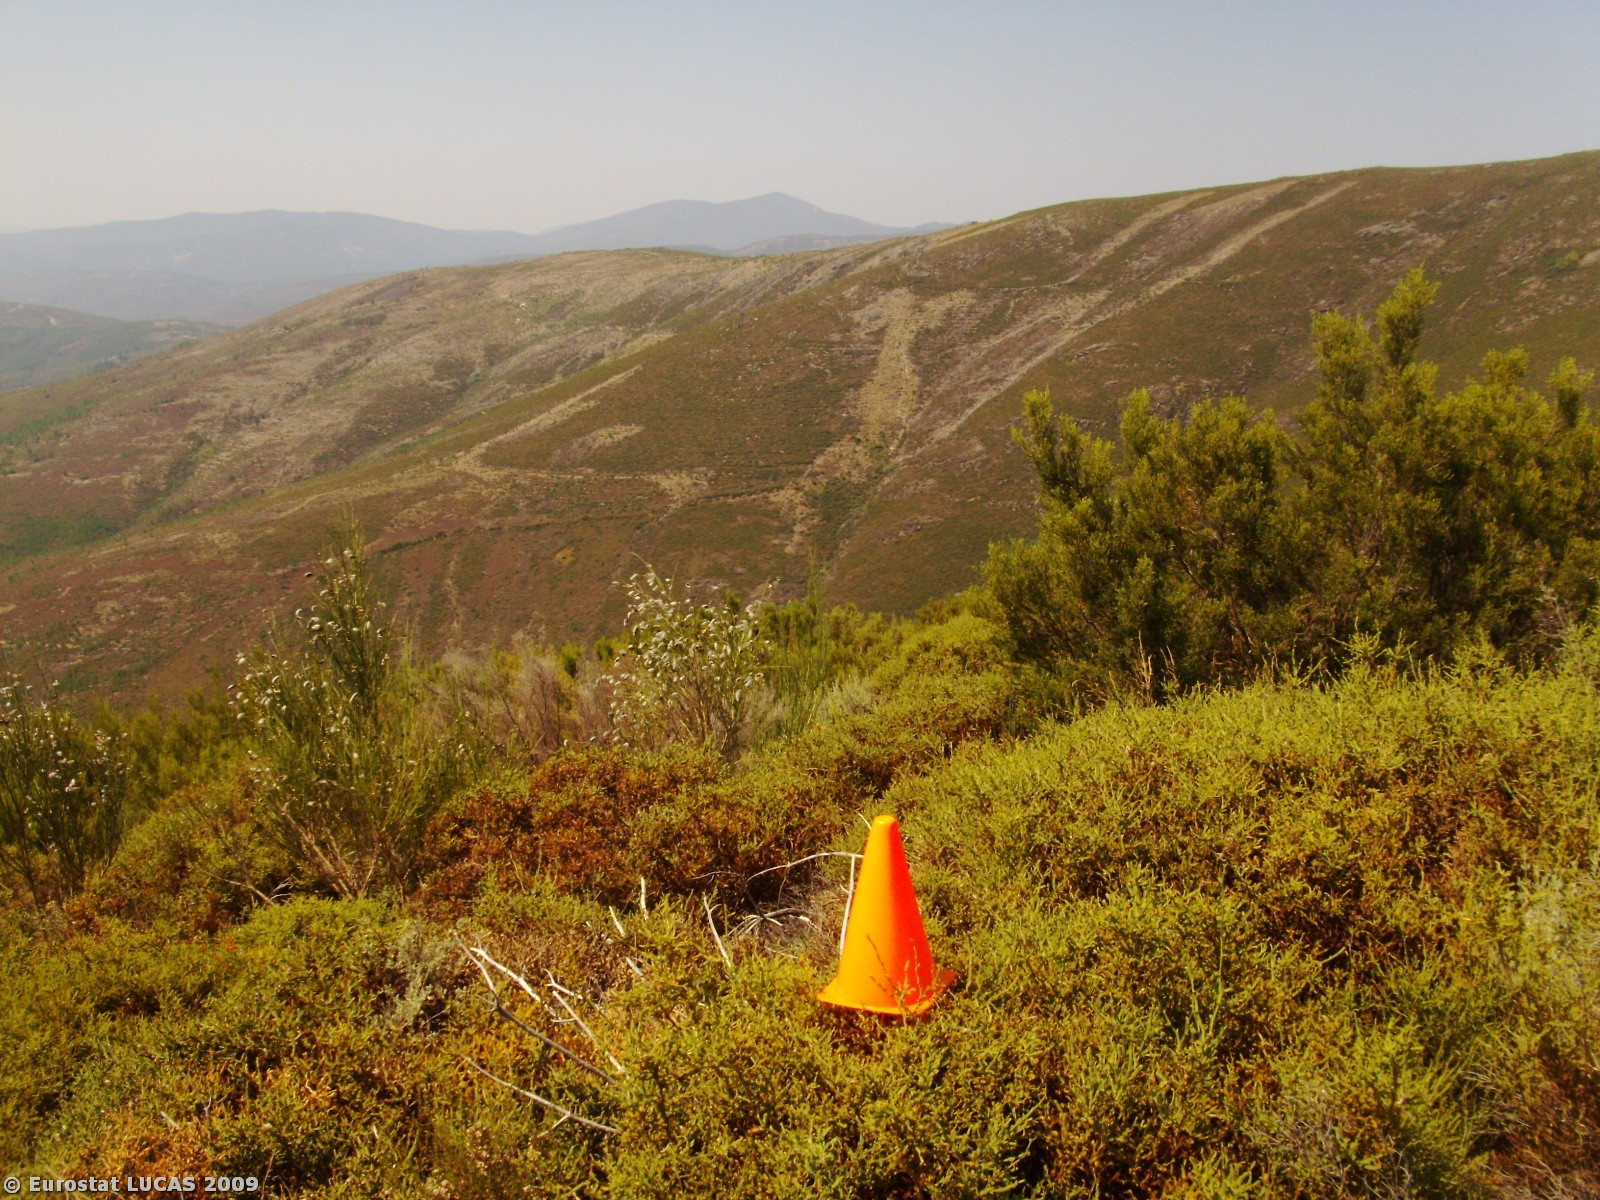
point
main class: Shrubland
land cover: Shrubland without tree cover
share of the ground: > 75 %
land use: Forestry
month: August
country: PT
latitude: 40.2607
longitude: -7.6418
